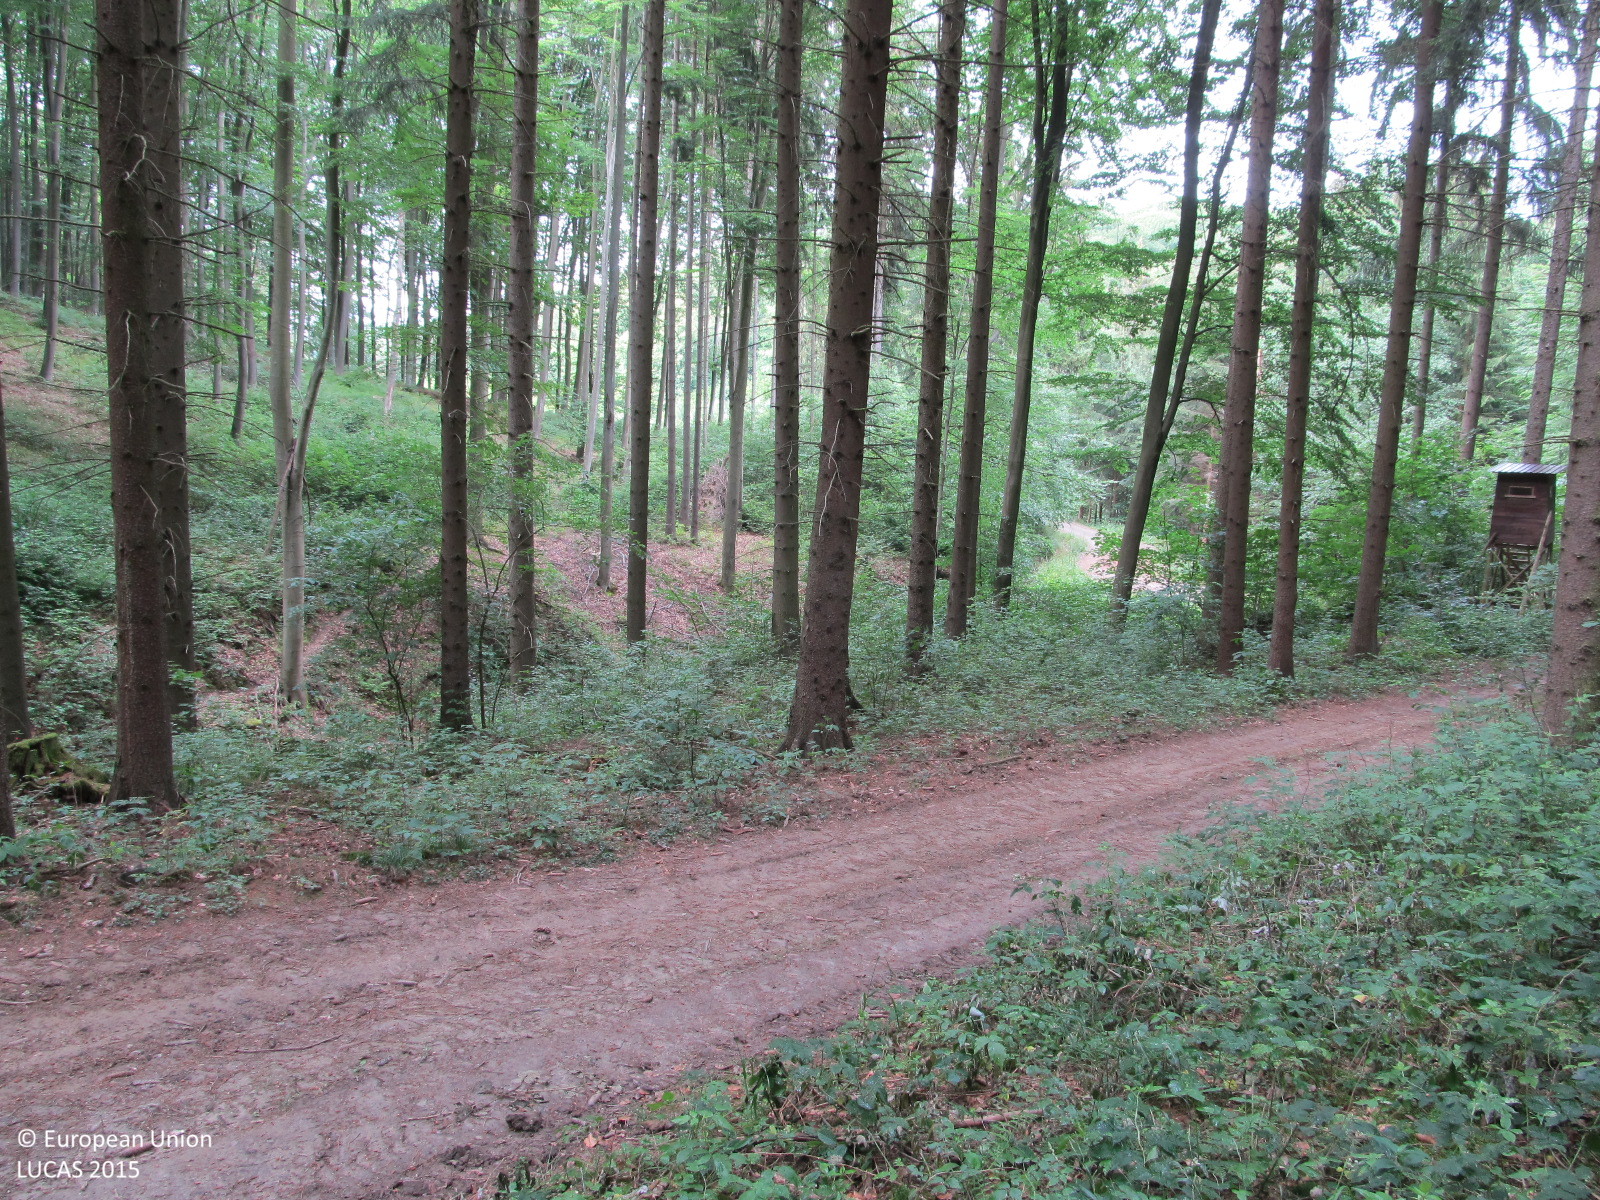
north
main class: Woodland
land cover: Spruce dominated mixed woodland
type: mountainous beech forest
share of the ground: > 75 %
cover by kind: coniferous forest trees 60 %, broadleaved forest trees 25 %, unconsolidated bare surface 10 %, shrubs 5 %
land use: Forestry
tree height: > 5 m
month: July
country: AT
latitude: 48.8260
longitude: 15.8477
